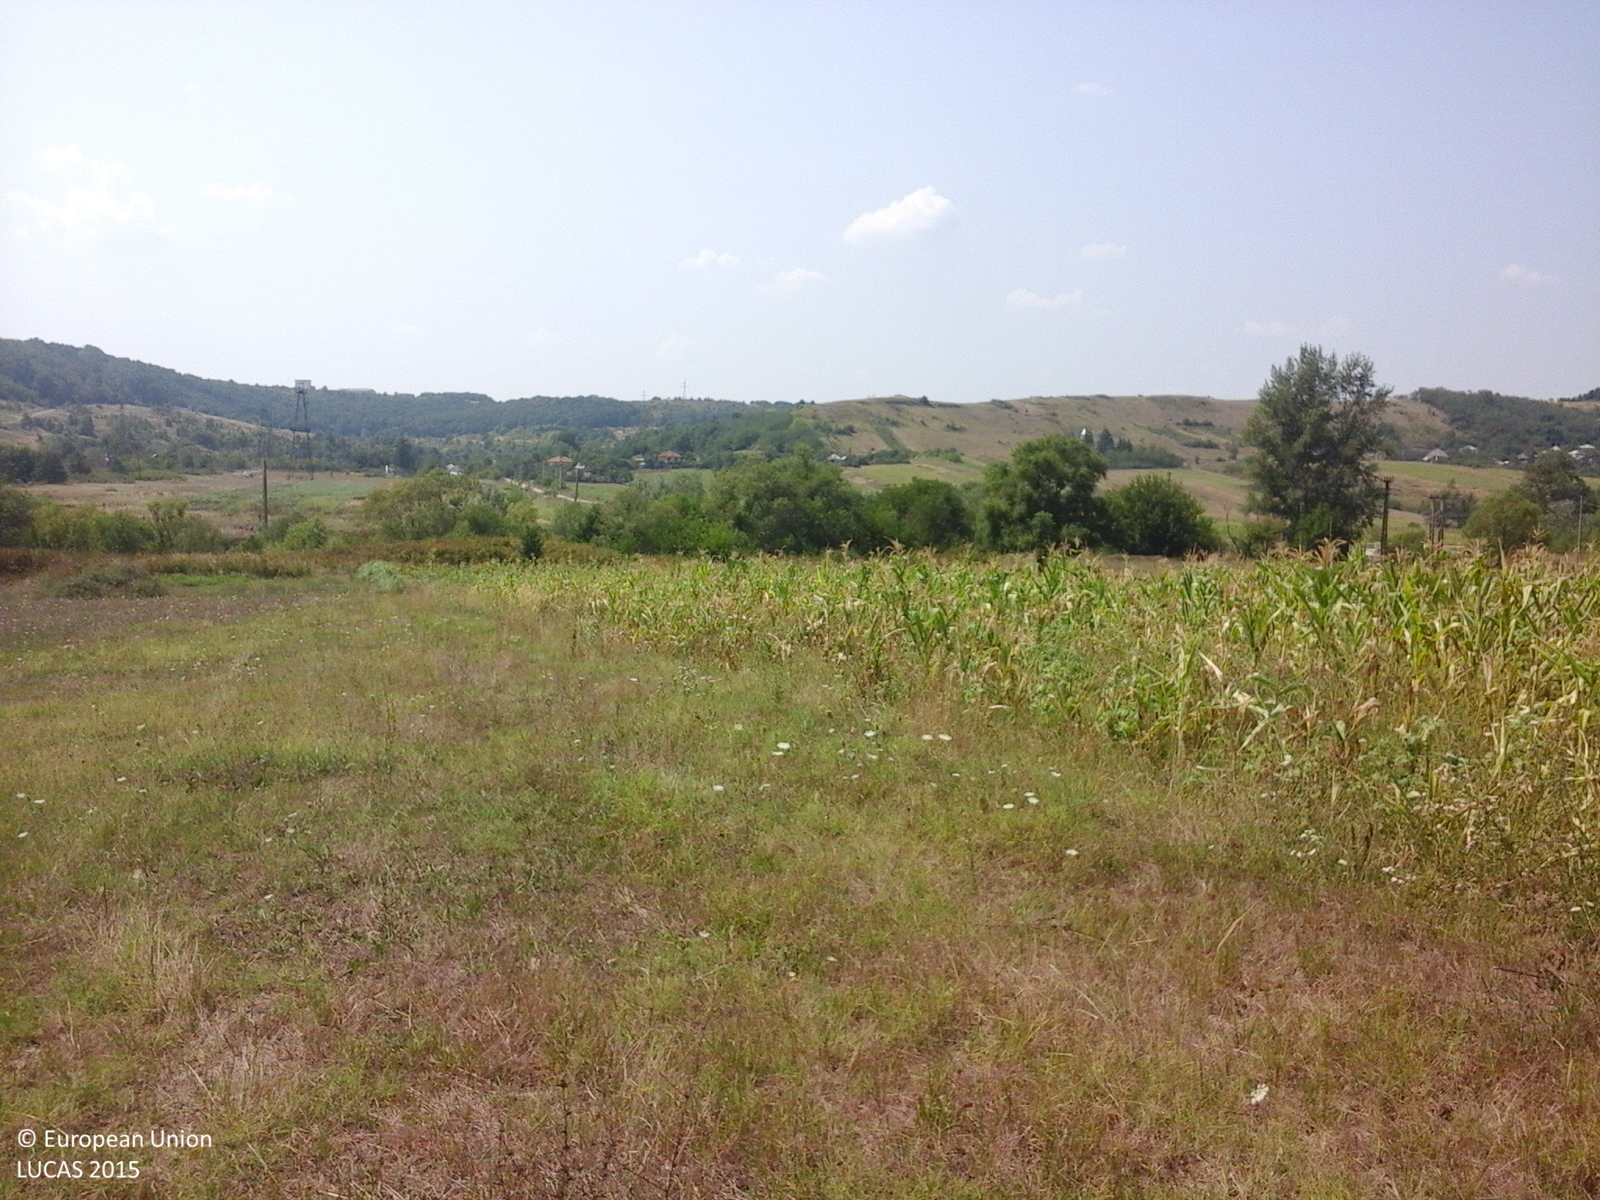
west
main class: Grassland
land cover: Grassland without tree/shrub cover
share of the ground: > 75 %
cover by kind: herbaceous plants 100 %
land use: Agriculture (excluding fallow land and kitchen gardens)
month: August
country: RO
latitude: 44.6733
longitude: 23.7455
